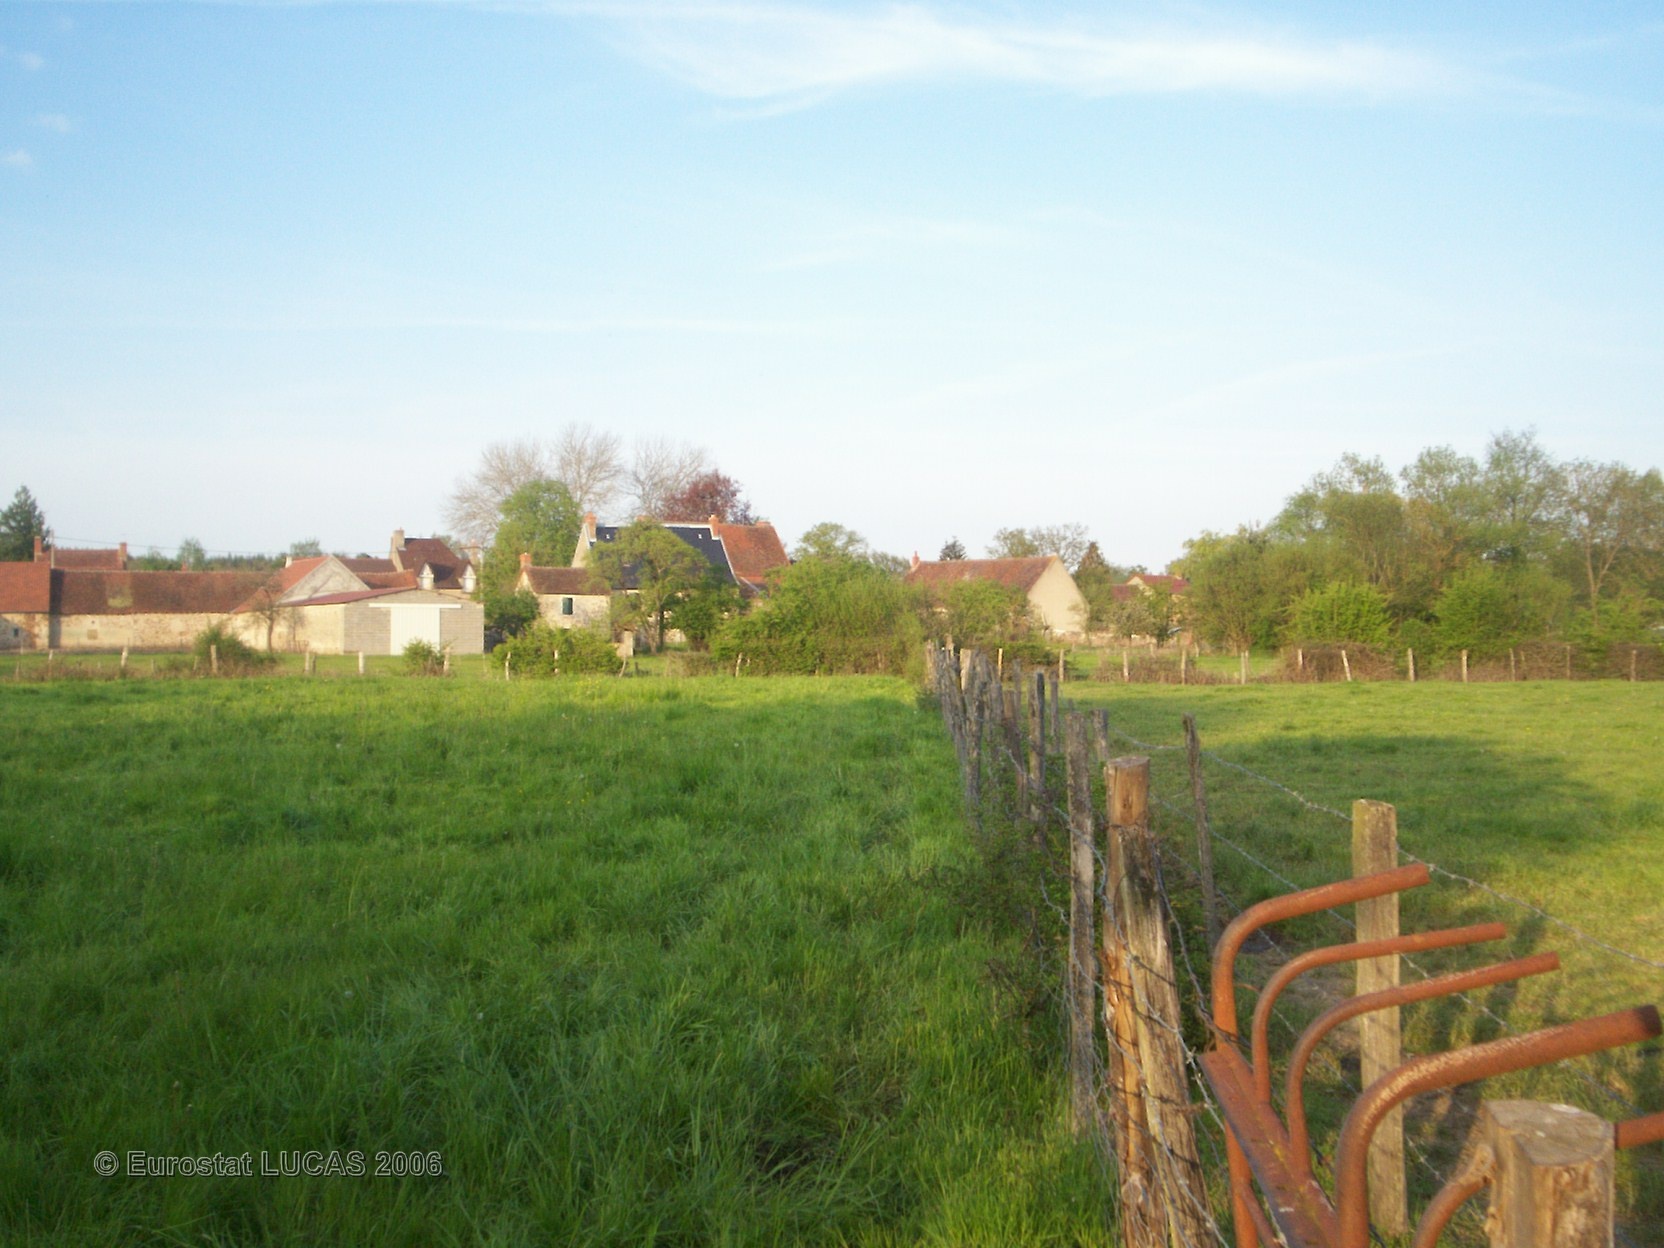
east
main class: Grassland
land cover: Grassland without tree/shrub cover
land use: Agriculture (excluding fallow land and kitchen gardens)
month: May
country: FR
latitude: 46.2375
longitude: 3.1123
